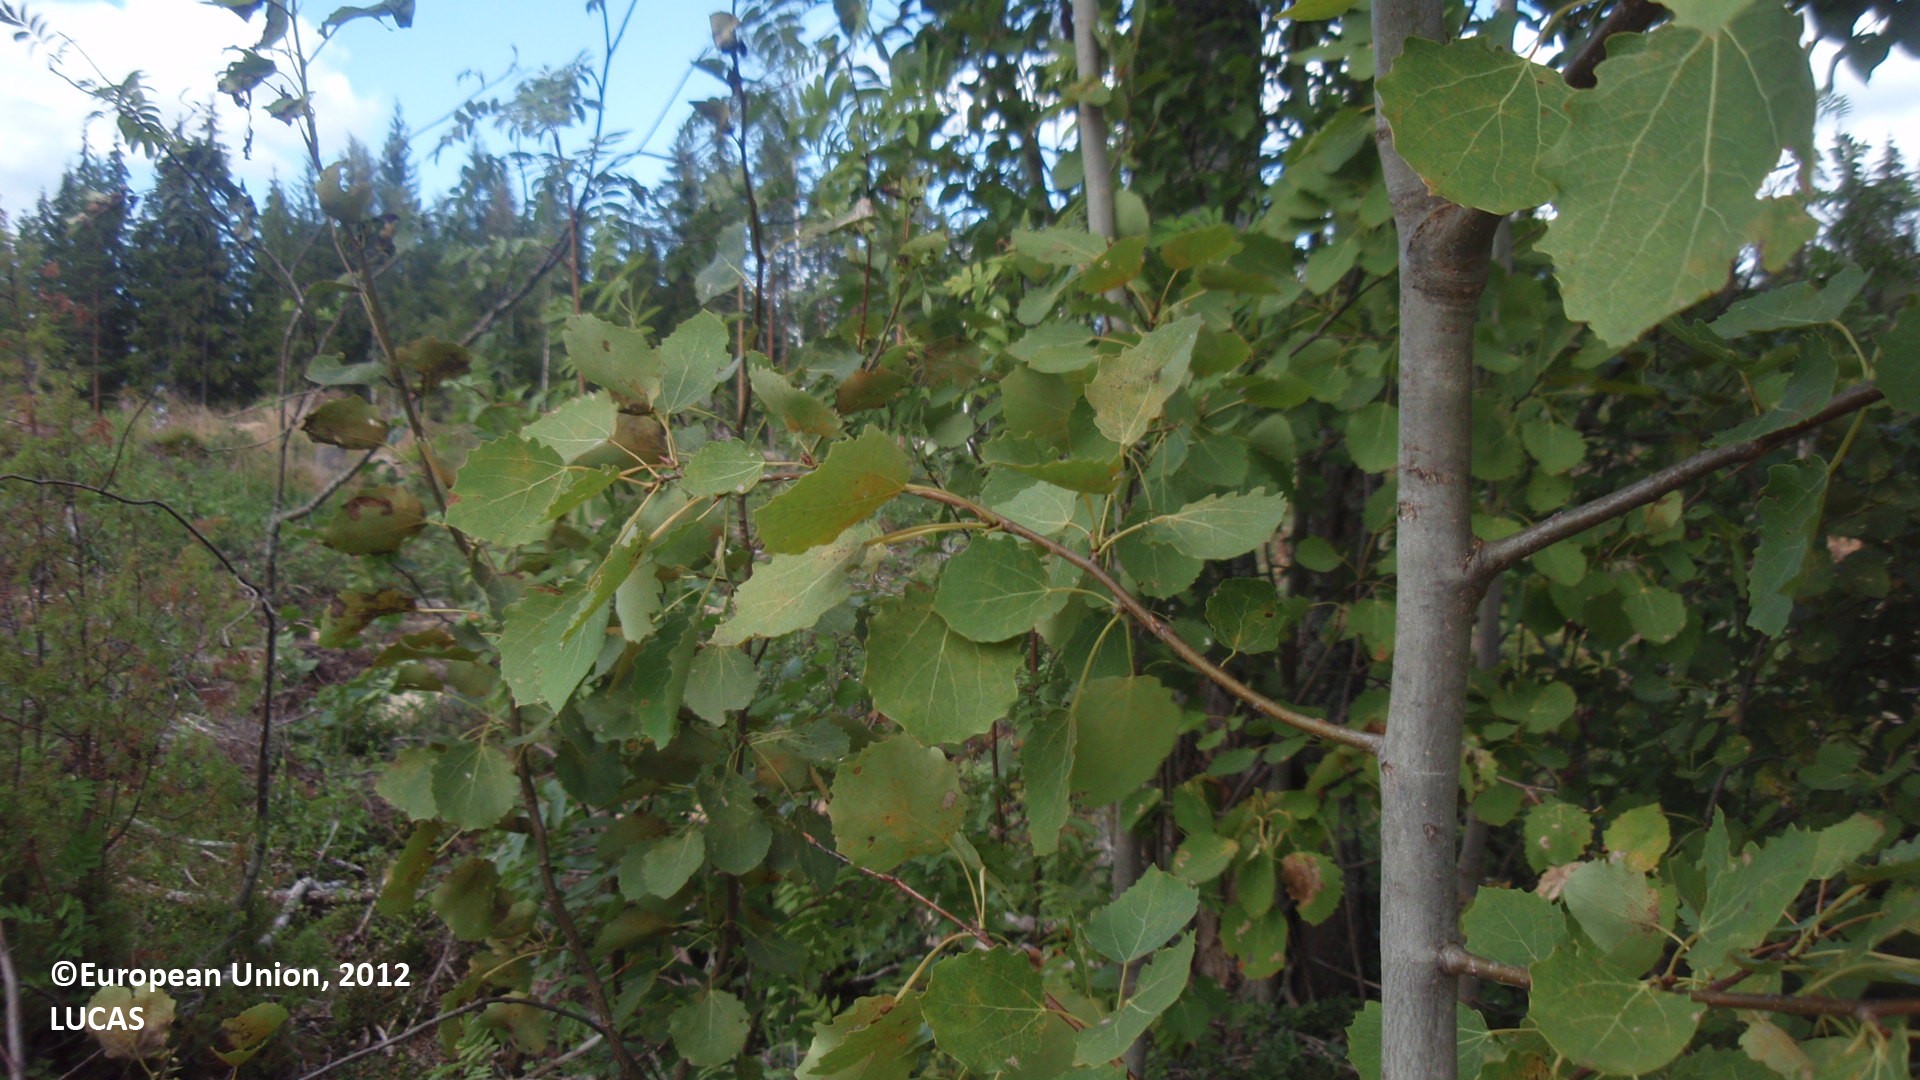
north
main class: Cropland
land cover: Common wheat
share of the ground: > 75 %
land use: Agriculture (excluding fallow land and kitchen gardens)
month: August
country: FI
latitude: 60.6854
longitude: 27.4877
